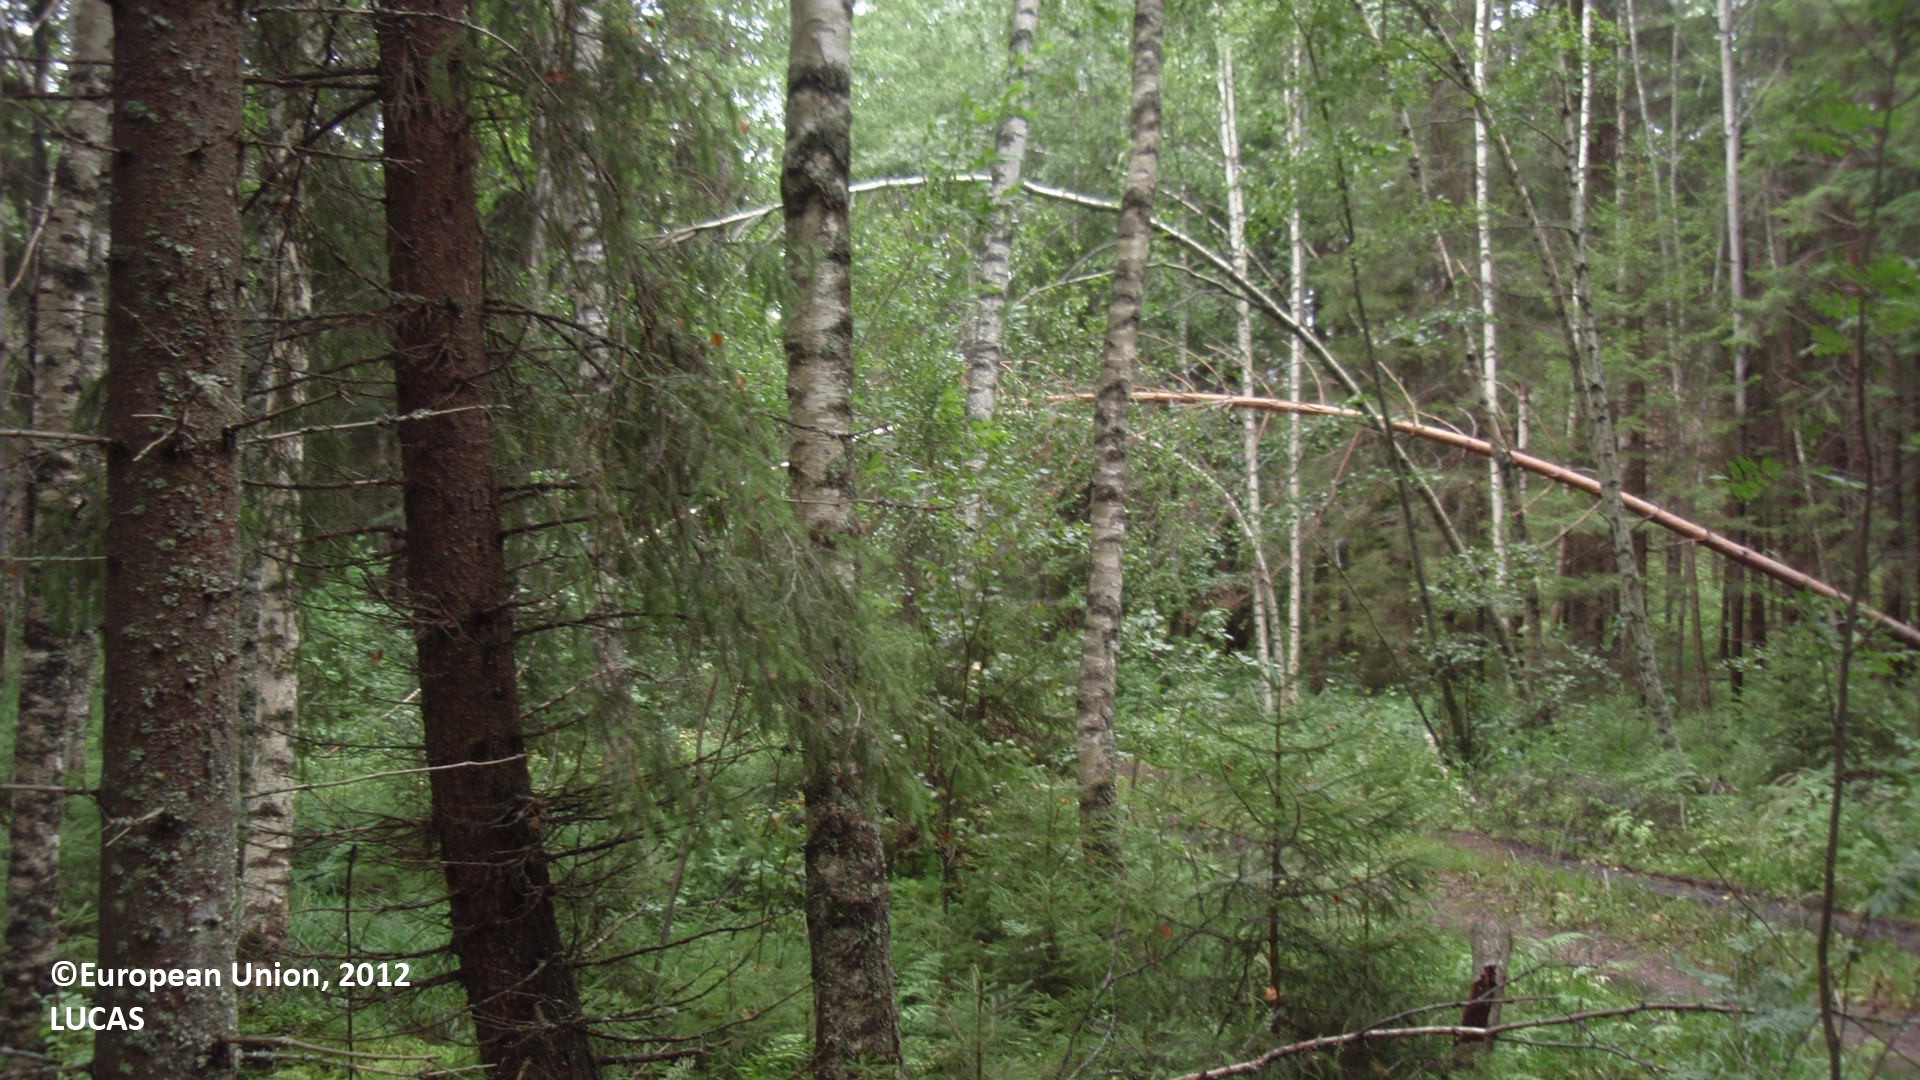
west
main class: Woodland
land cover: Spruce dominated mixed woodland
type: boreal forest
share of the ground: 50 - 75 %
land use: Forestry
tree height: > 5 m
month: August
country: FI
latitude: 61.0376
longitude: 27.3380
